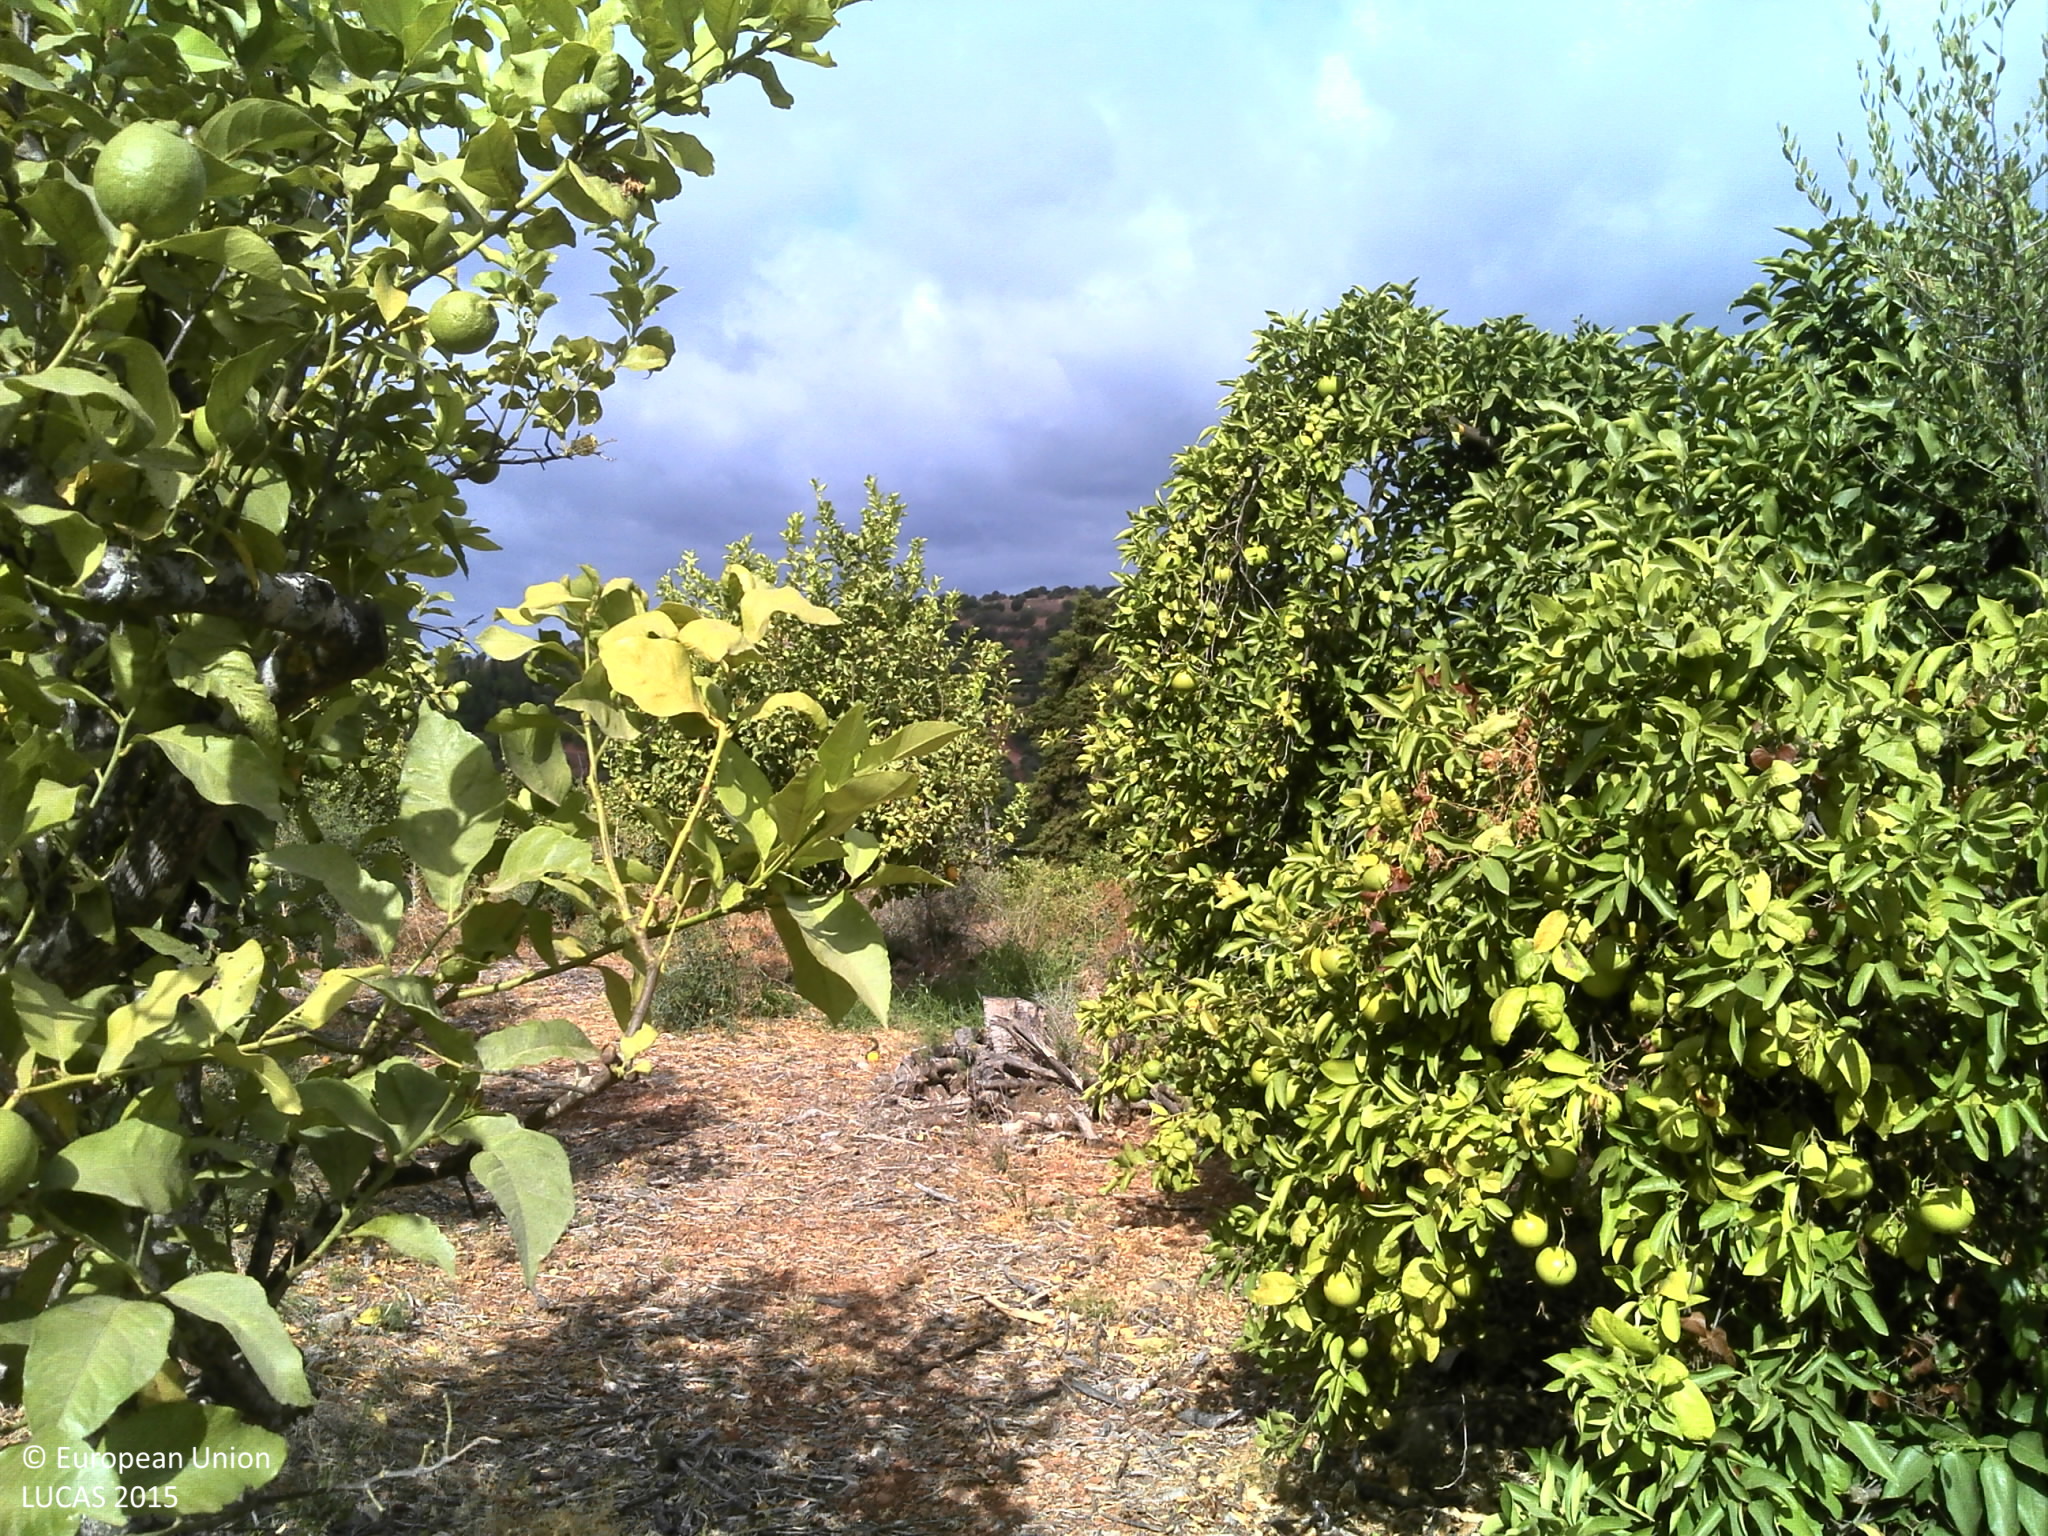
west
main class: Cropland
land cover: Other citrus fruit
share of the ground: 25 - 50 %
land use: Agriculture (excluding fallow land and kitchen gardens)
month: September
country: PT
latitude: 37.1959
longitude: -8.3981
